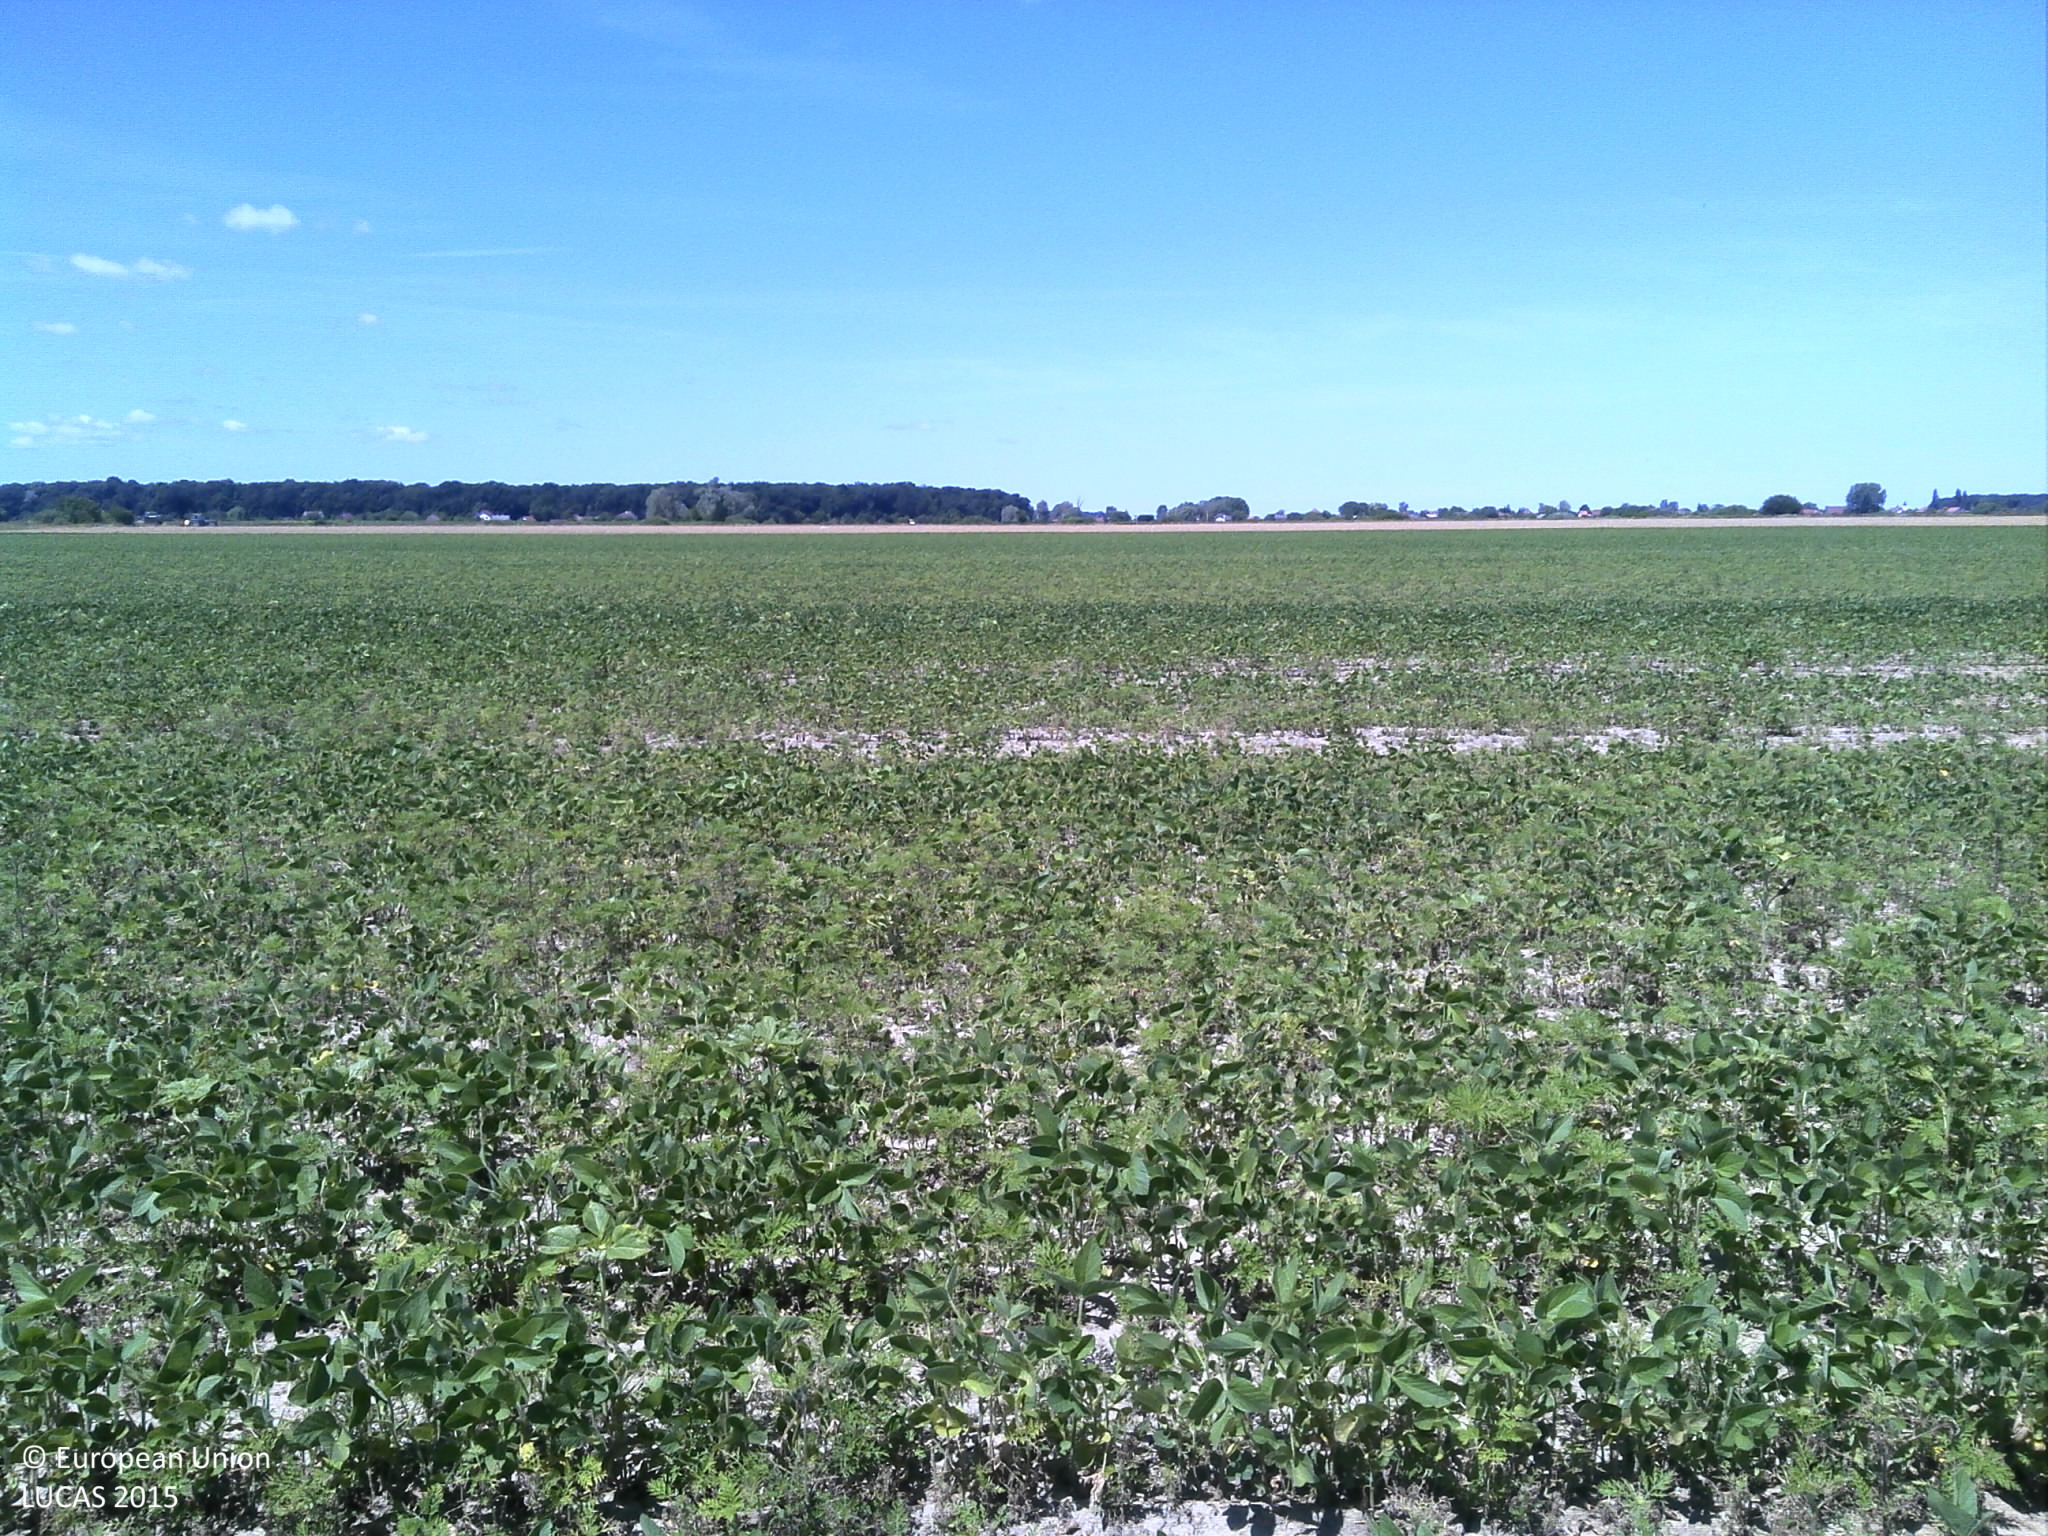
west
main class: Cropland
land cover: Soya
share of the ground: 50 - 75 %
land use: Agriculture (excluding fallow land and kitchen gardens)
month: June
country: HR
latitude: 45.7446
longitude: 17.9866
